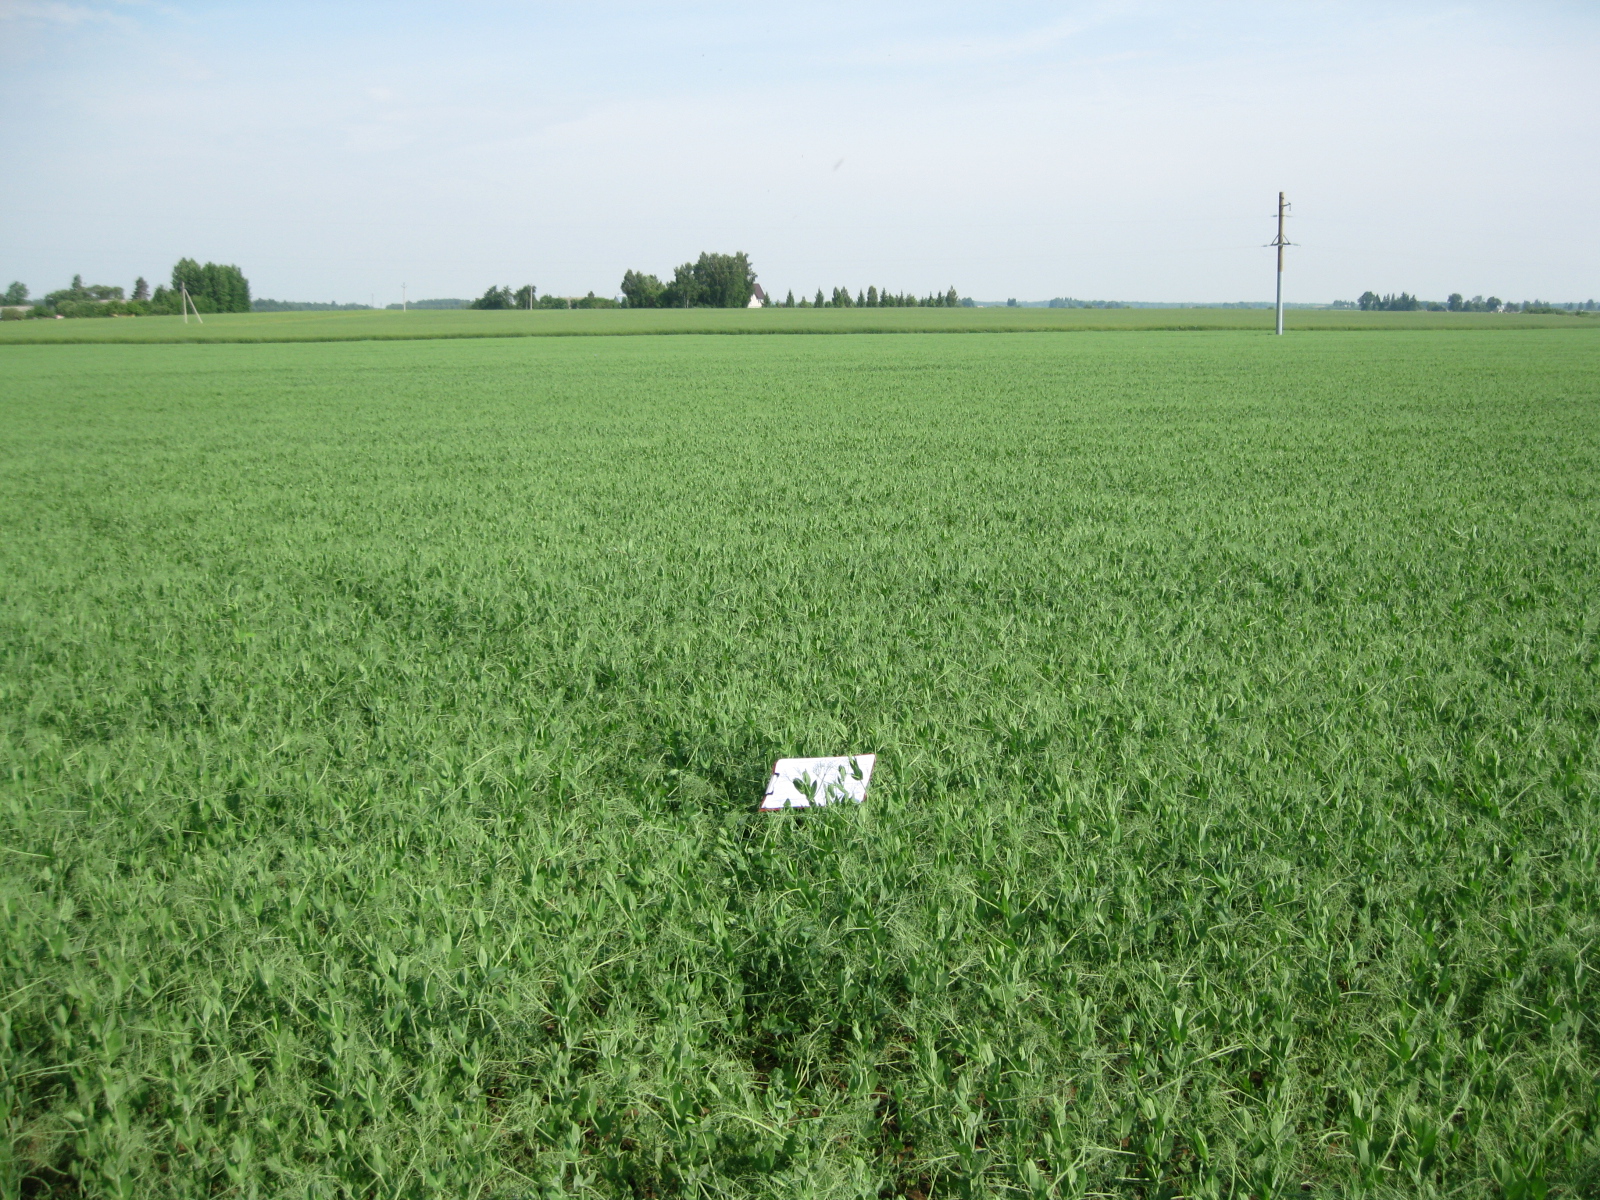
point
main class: Cropland
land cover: Dry pulses
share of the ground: > 75 %
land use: Agriculture (excluding fallow land and kitchen gardens)
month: June
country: LT
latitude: 55.3809
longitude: 23.4788
